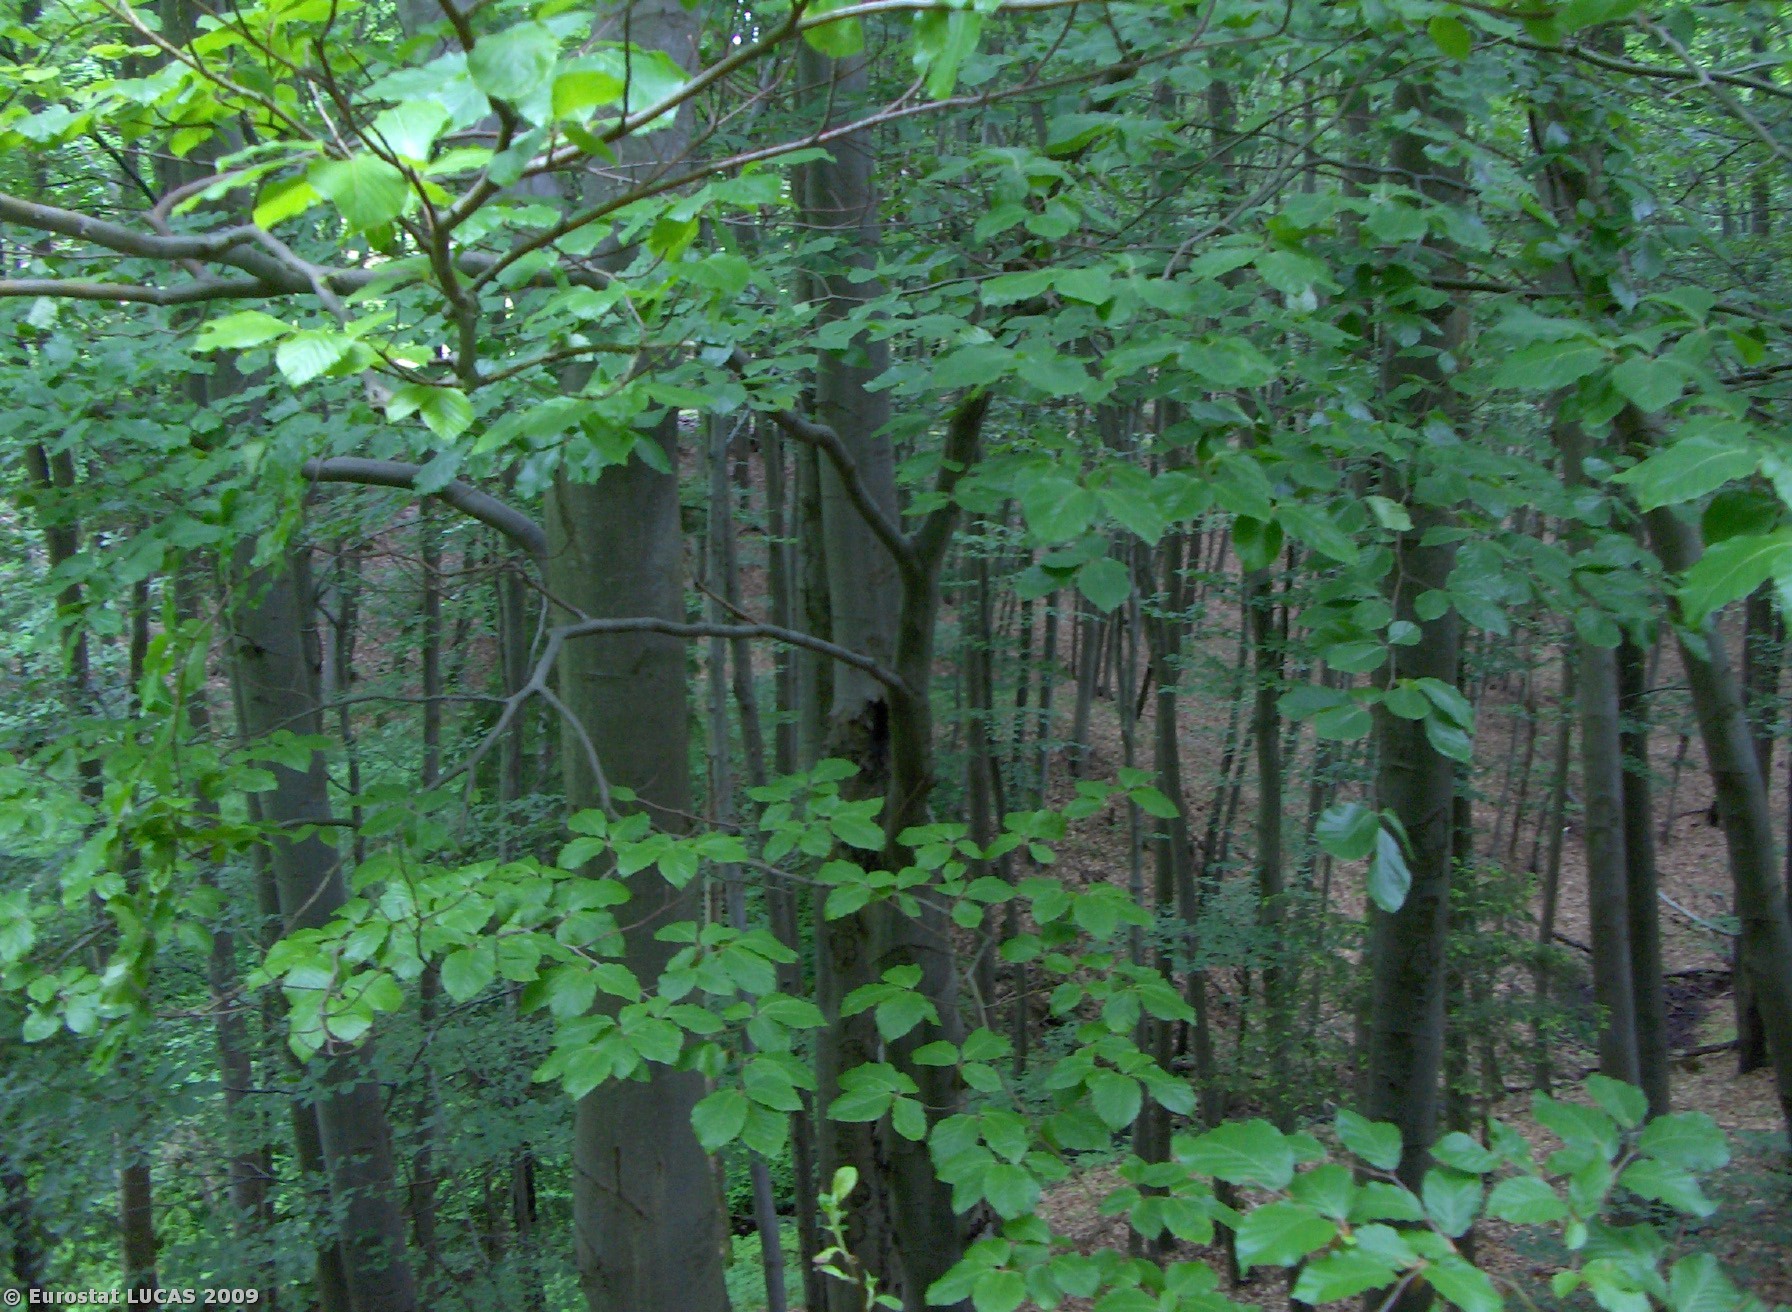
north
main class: Woodland
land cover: Mixed woodland
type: hemiboreal forest and nemoral coniferous forest and mixed broadleaved-coniferous forest
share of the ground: > 75 %
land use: Forestry
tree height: > 5 m
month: May
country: CZ
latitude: 49.1066
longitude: 14.4531
